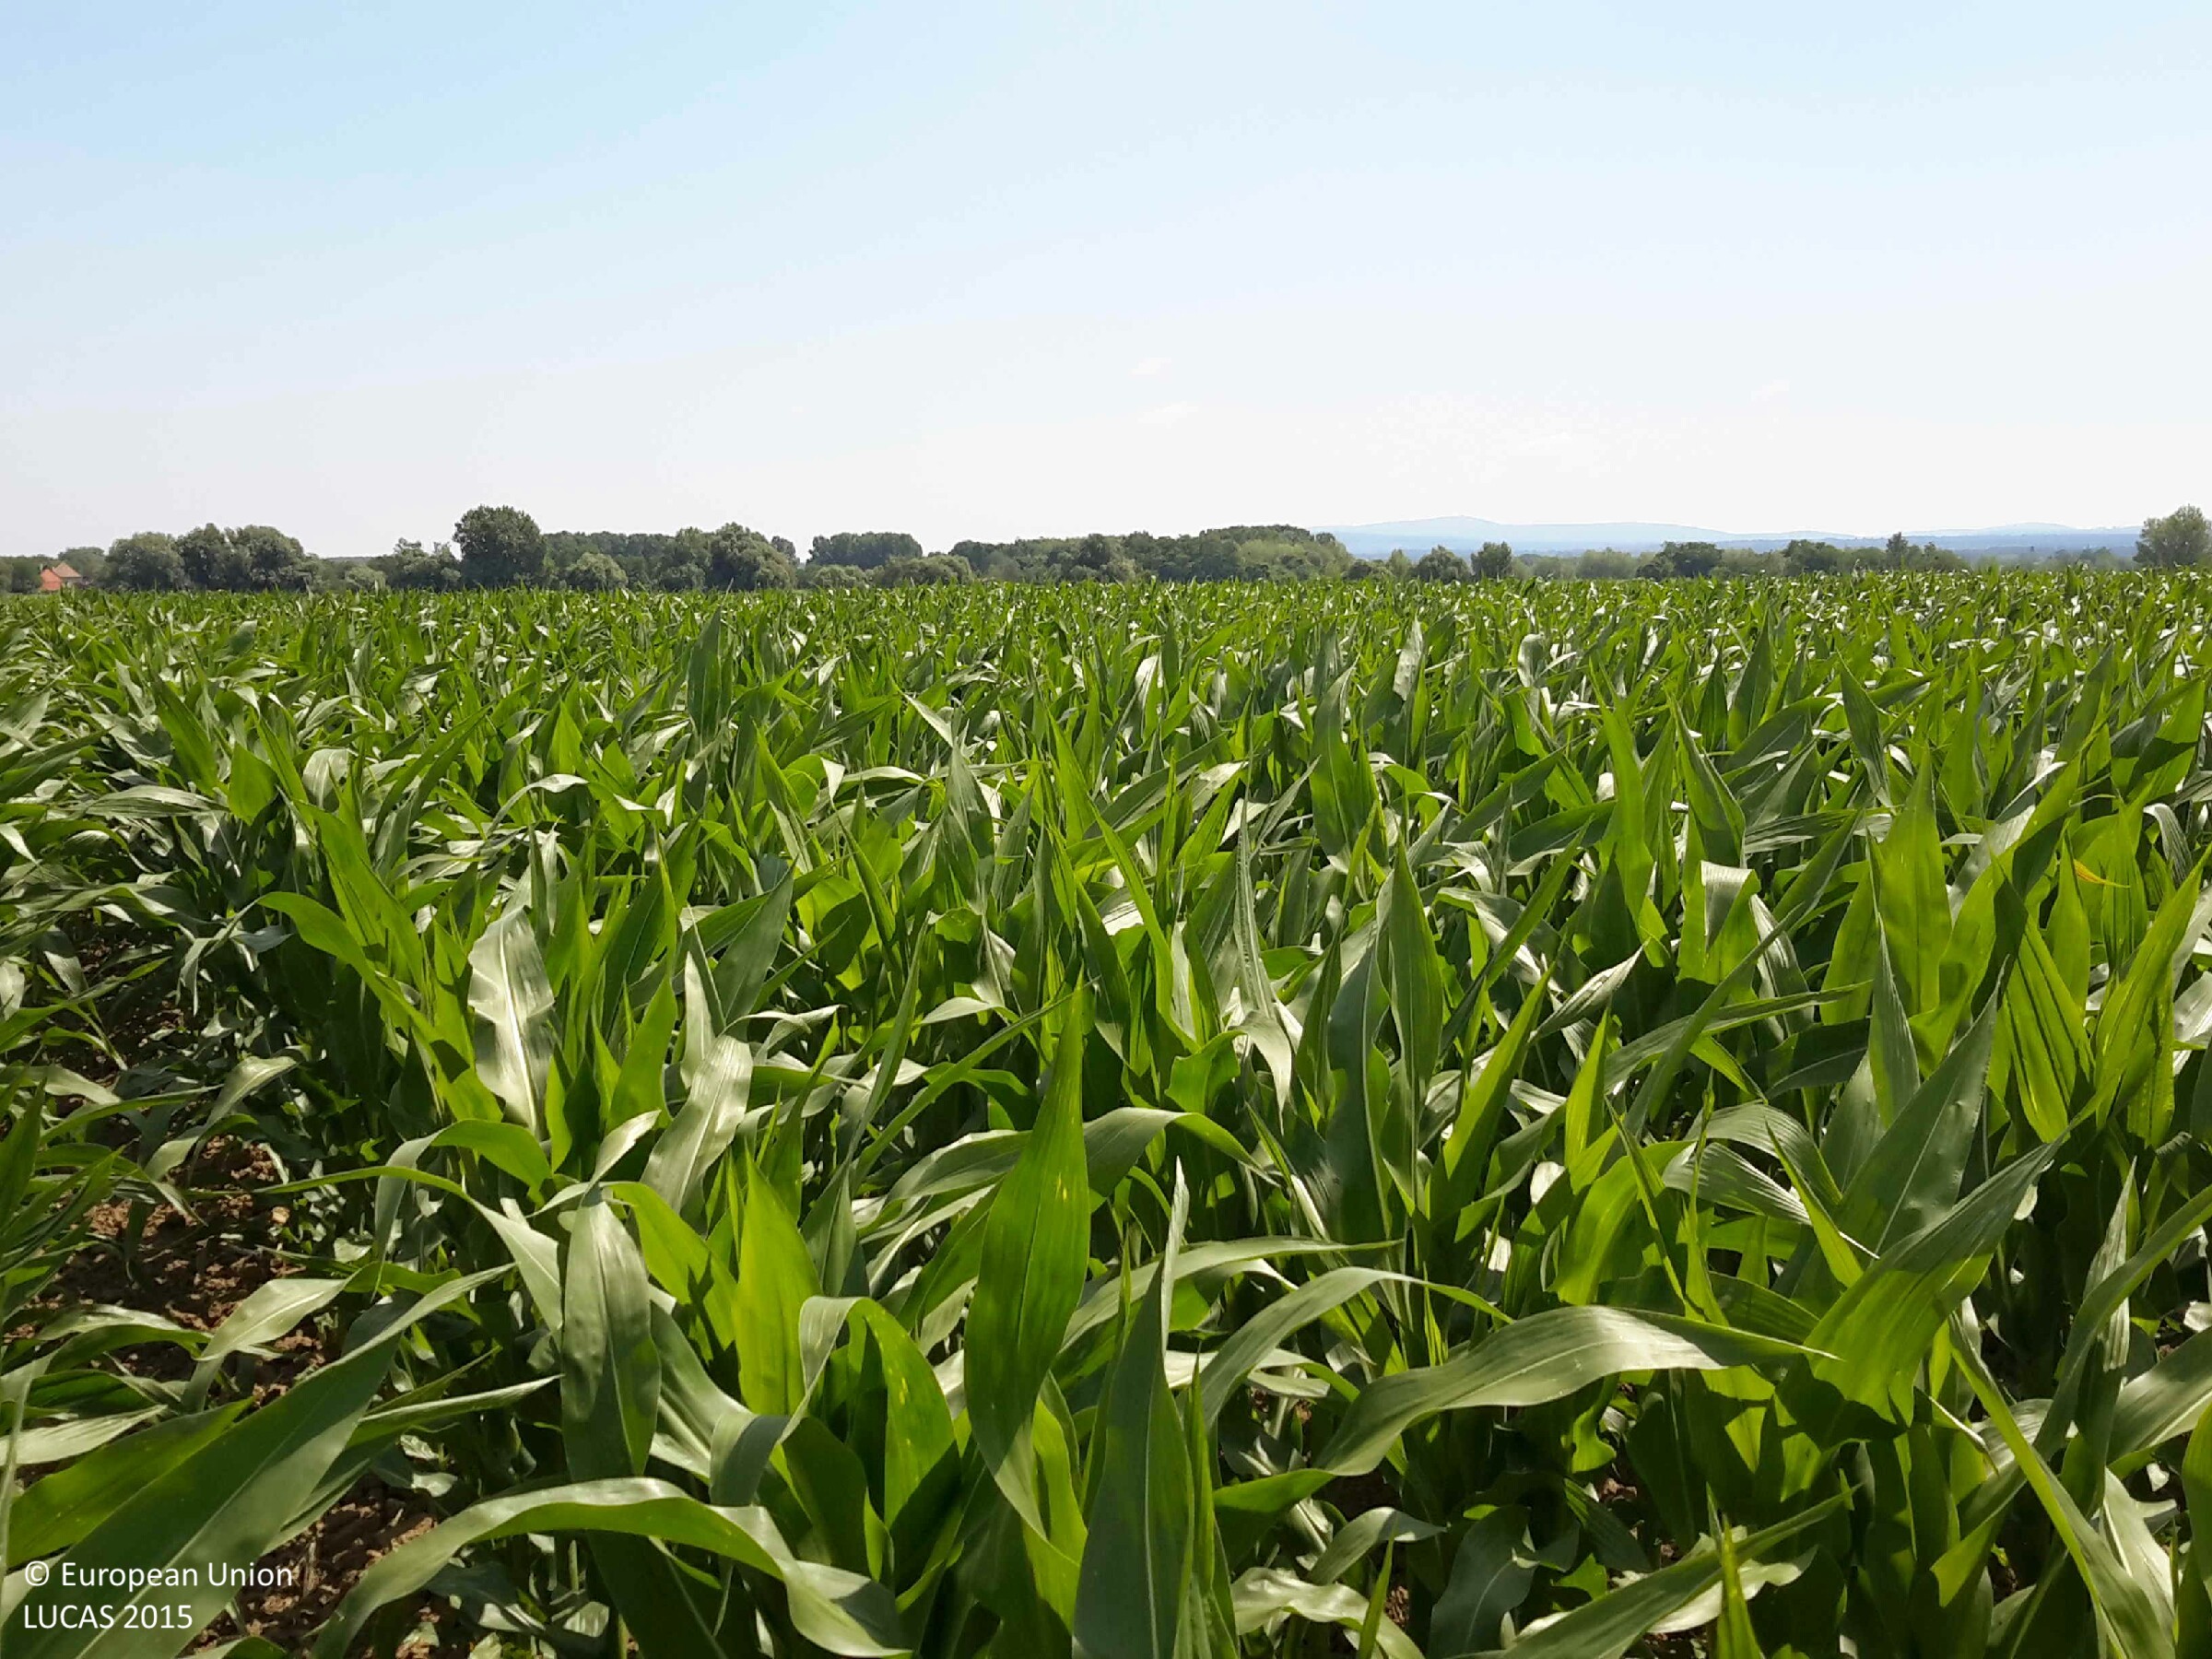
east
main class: Cropland
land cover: Maize
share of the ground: 50 - 75 %
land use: Agriculture (excluding fallow land and kitchen gardens)
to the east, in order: Maize; Common wheat; Grass margins; Tracks; Grass margins; Maize
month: June
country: HU
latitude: 47.2666
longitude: 17.4482
